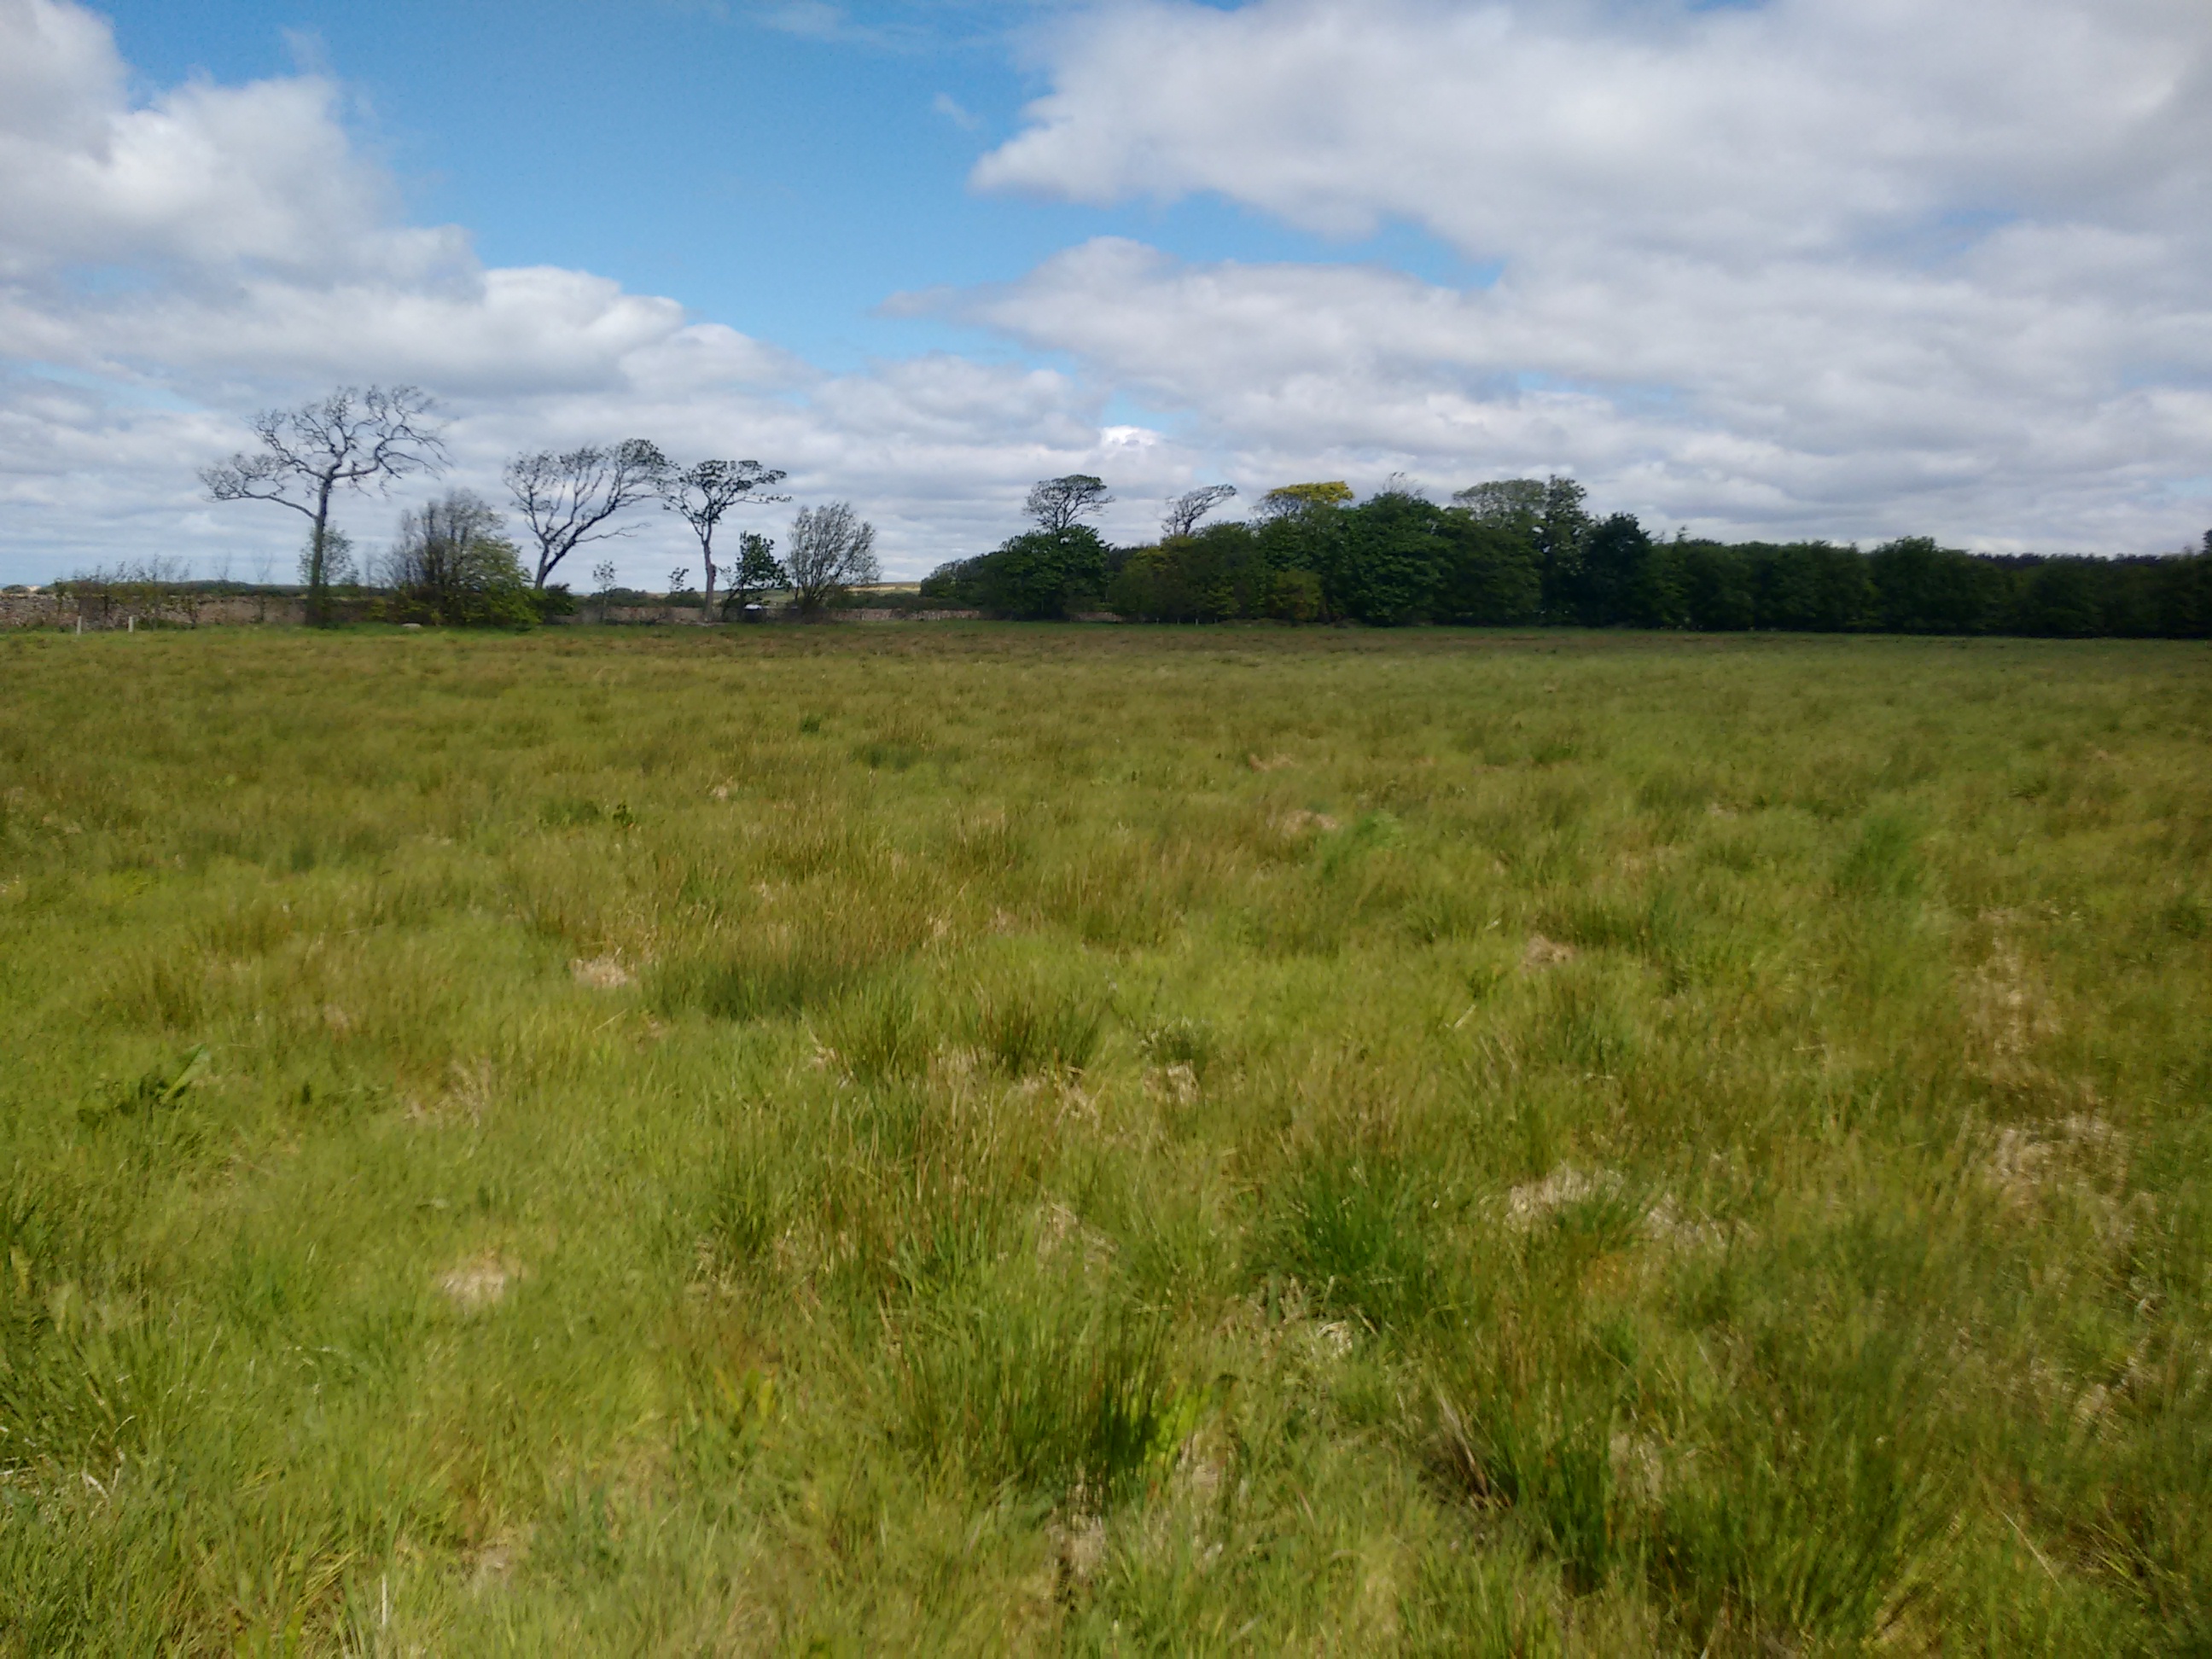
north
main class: Grassland
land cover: Grassland without tree/shrub cover
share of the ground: > 75 %
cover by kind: herbaceous plants 100 %
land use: Agriculture (excluding fallow land and kitchen gardens)
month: May
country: GB
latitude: 56.0124
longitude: -2.8489
